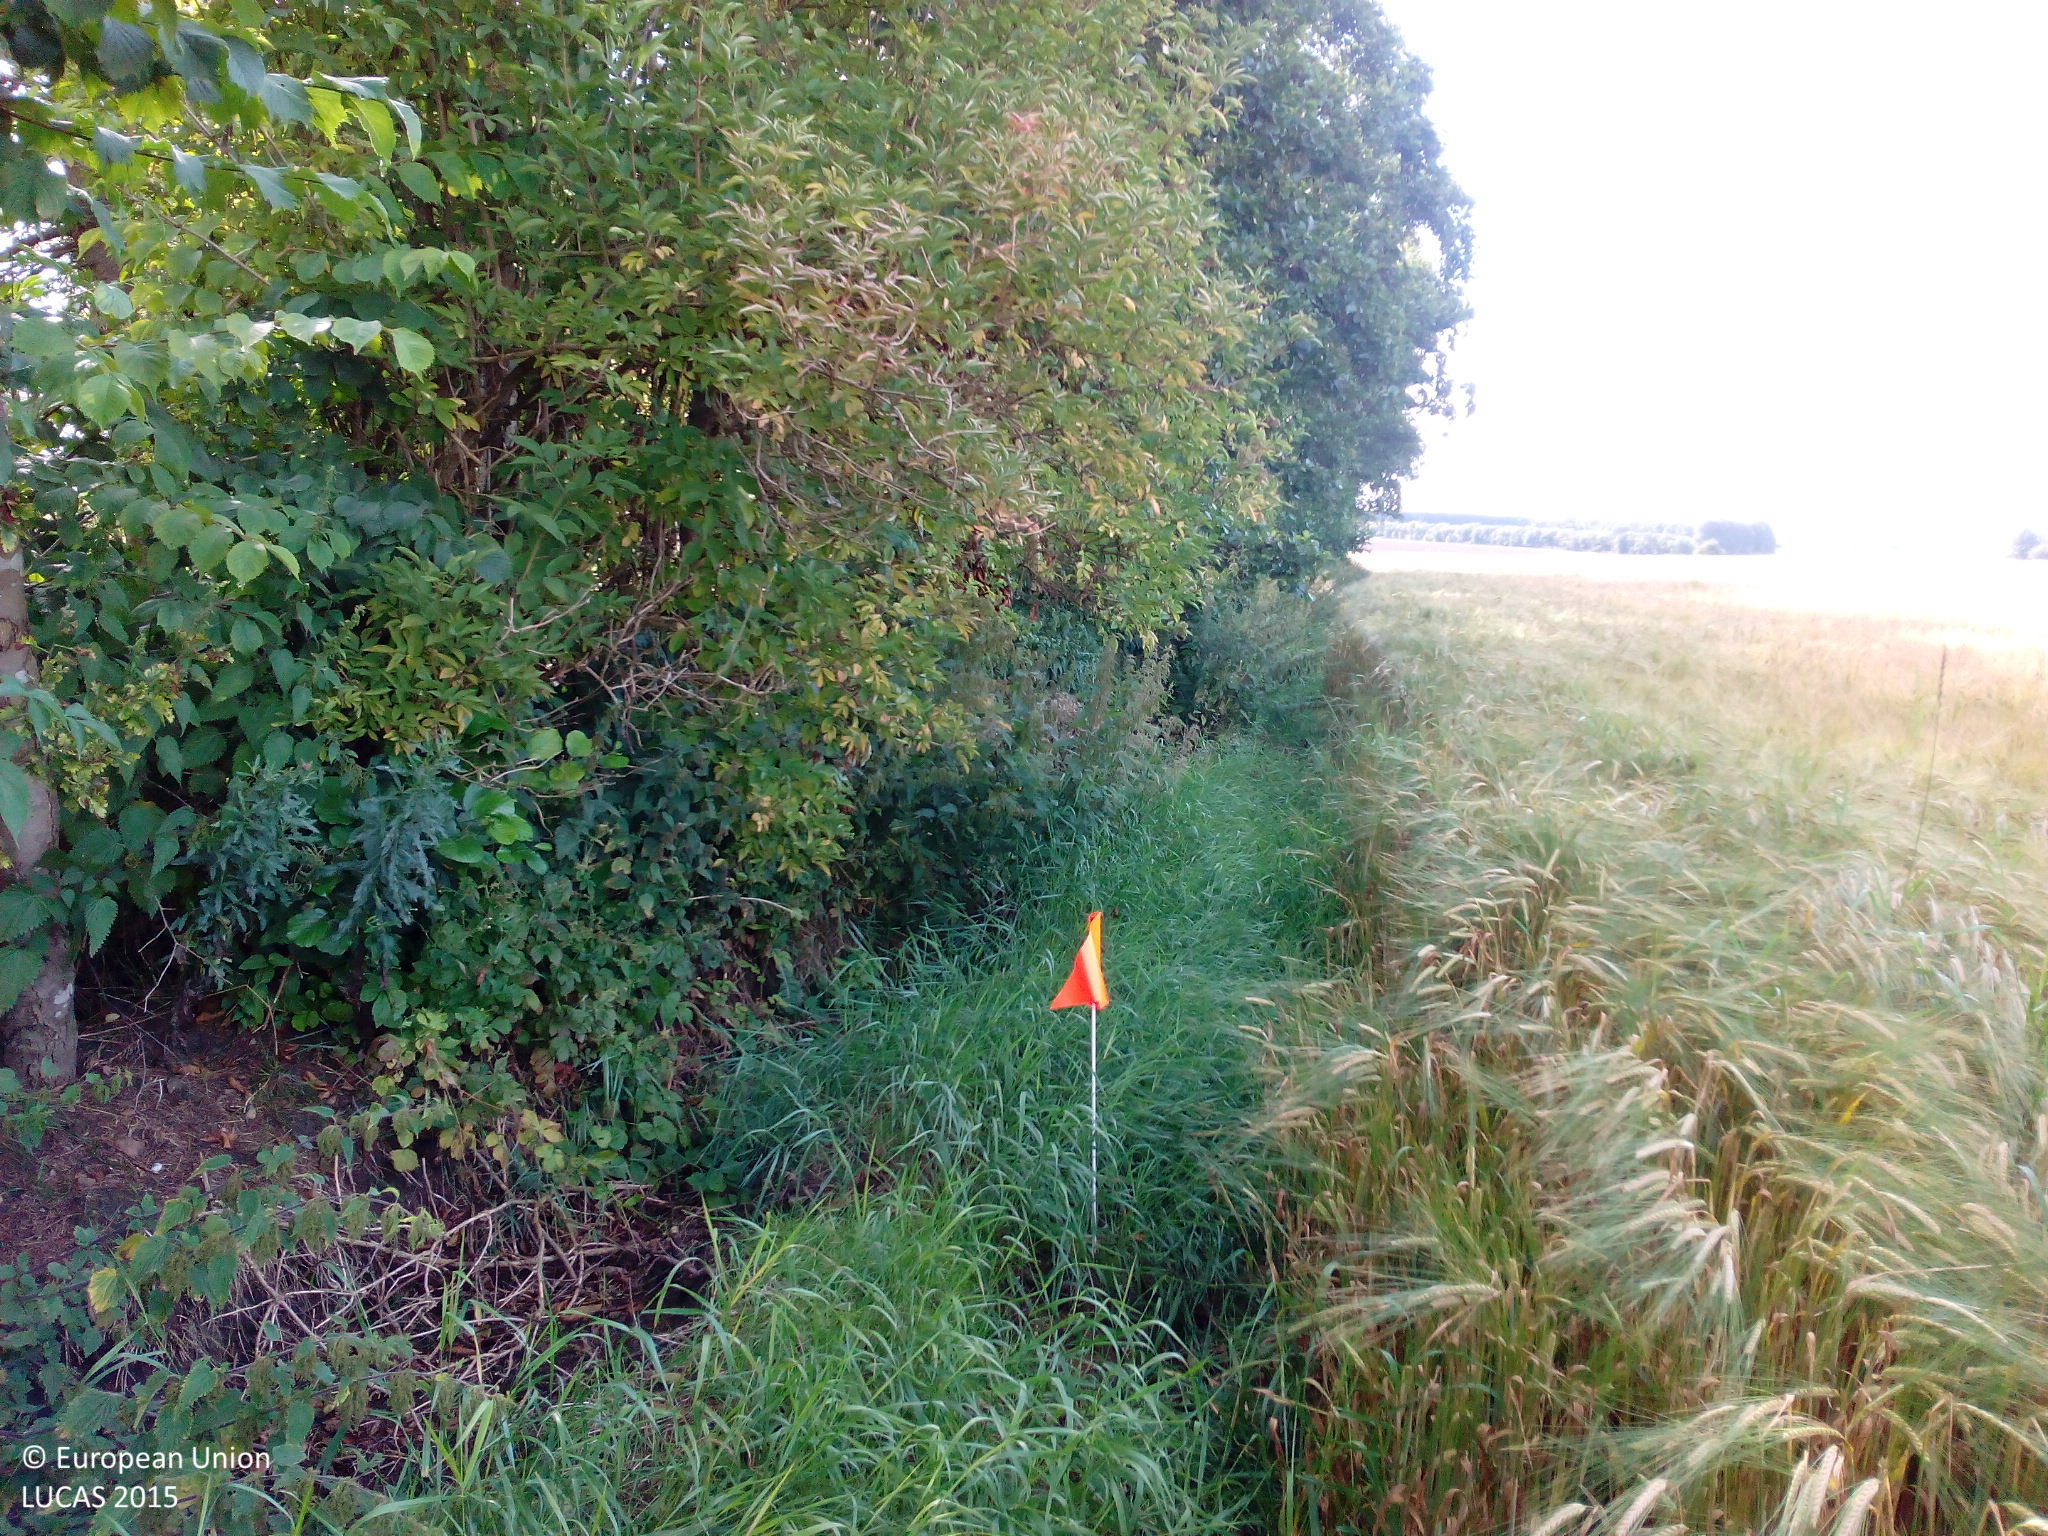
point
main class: Cropland
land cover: Barley
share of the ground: > 75 %
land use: Agriculture (excluding fallow land and kitchen gardens)
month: August
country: DK
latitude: 55.5956
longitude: 12.0771
